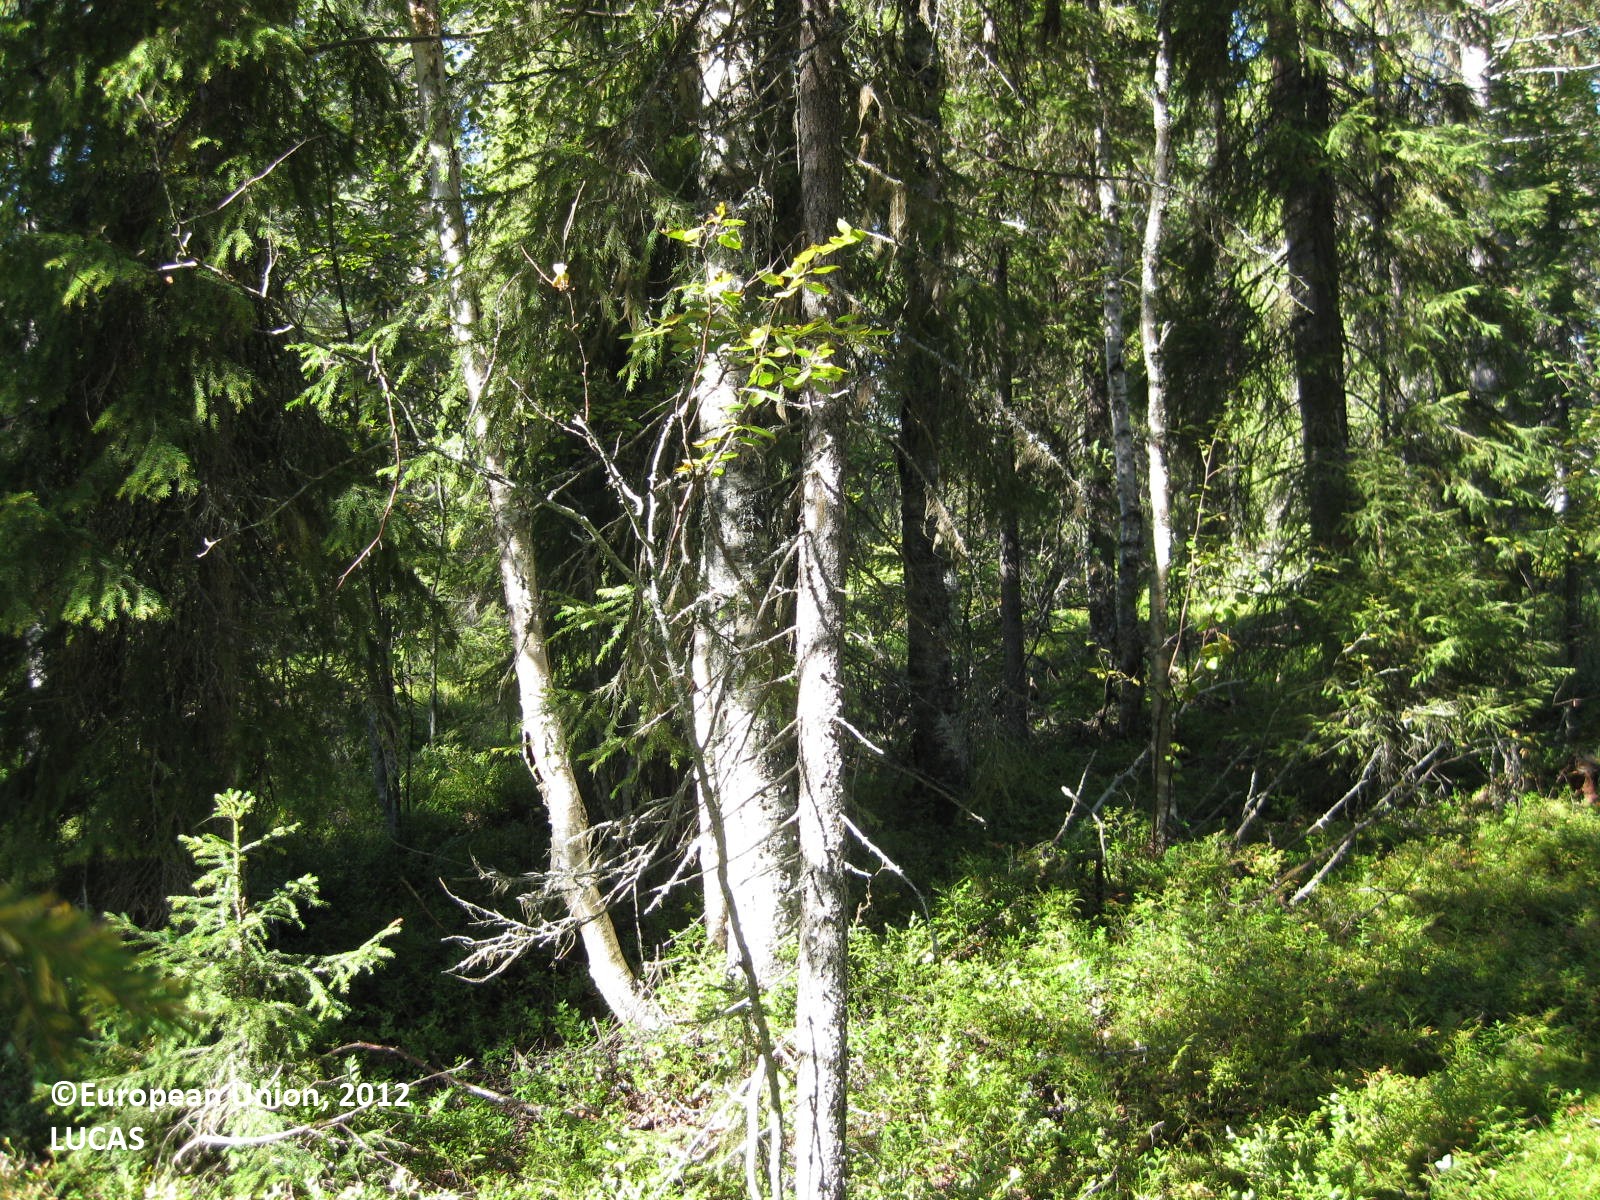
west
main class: Woodland
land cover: Other coniferous woodland
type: boreal forest
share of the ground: 50 - 75 %
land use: Forestry
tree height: > 5 m
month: August
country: FI
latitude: 66.0612
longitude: 29.7913
